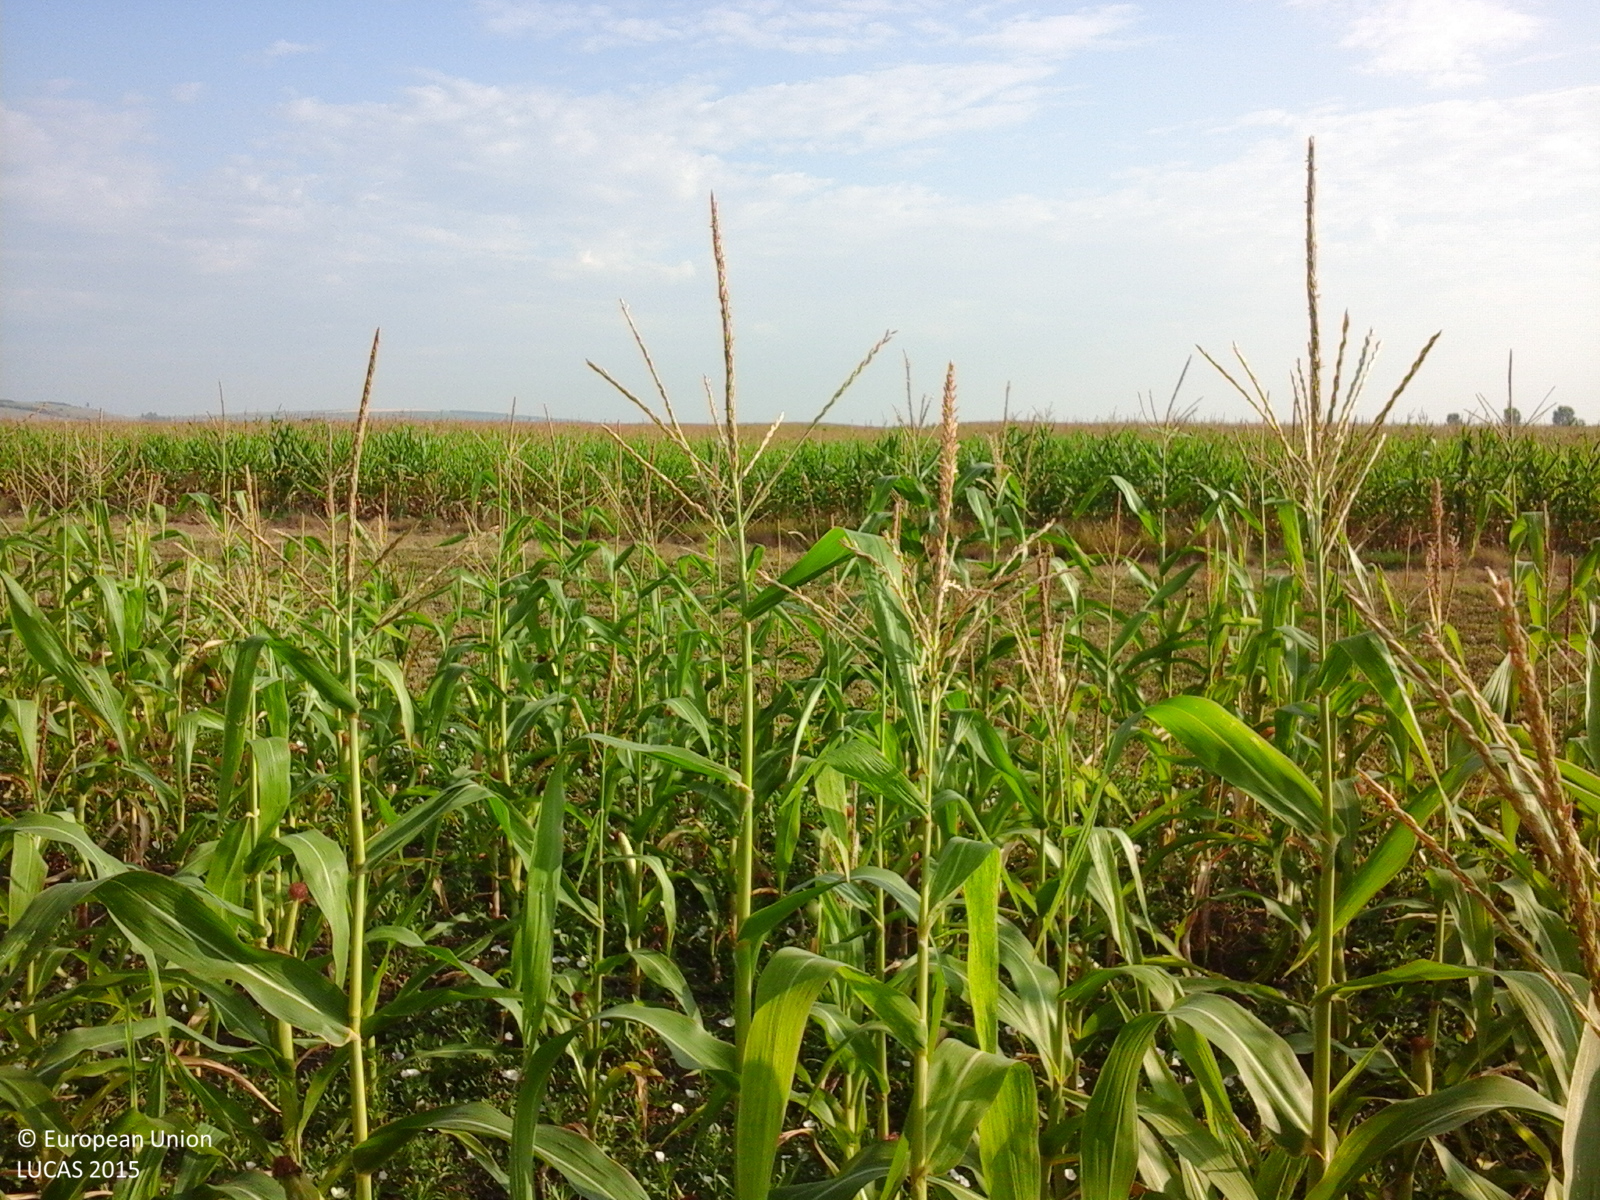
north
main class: Cropland
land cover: Maize
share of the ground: > 75 %
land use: Agriculture (excluding fallow land and kitchen gardens)
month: July
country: RO
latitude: 46.2921
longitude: 28.1604
